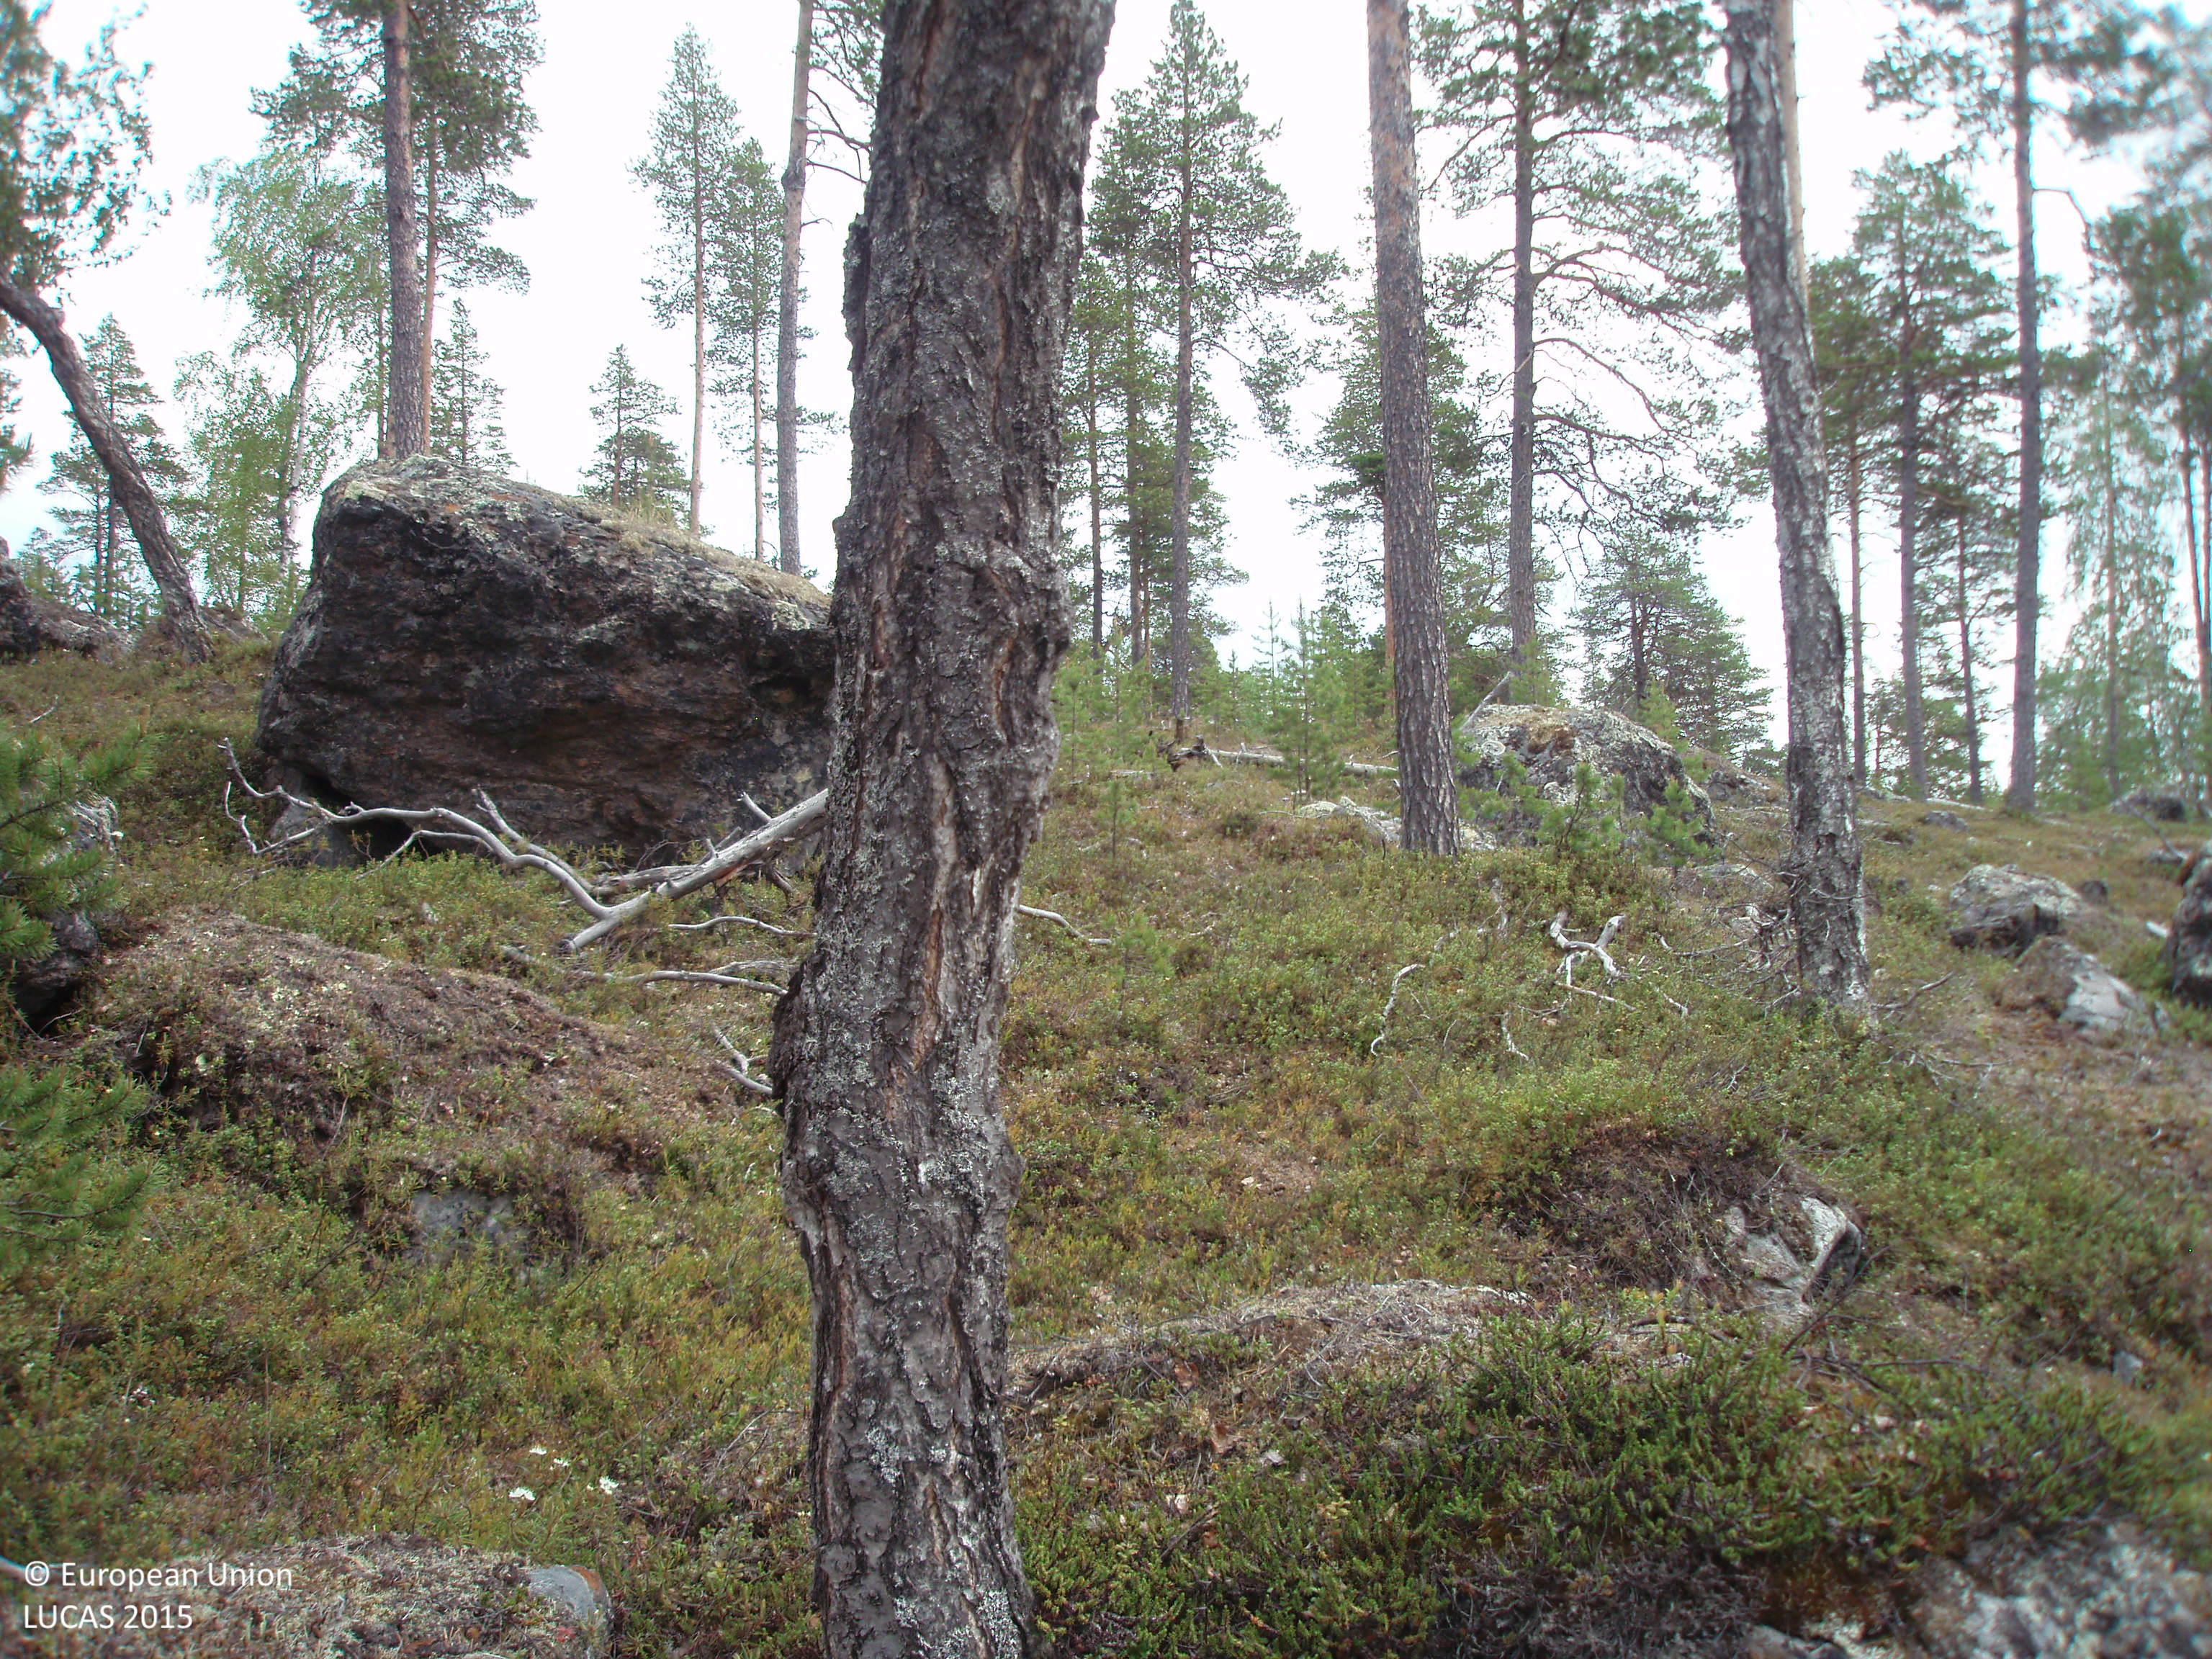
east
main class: Woodland
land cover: Pine dominated coniferous woodland
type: boreal forest
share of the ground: 25 - 50 %
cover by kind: shrubs 55 %, coniferous forest trees 30 %, broadleaved forest trees 5 %, lichens and mosses 5 %, unconsolidated bare surface 5 %
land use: Forestry
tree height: > 5 m
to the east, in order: Pine dominated coniferous woodland; Pine dominated mixed woodland; Pine dominated coniferous woodland
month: June
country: FI
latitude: 68.8054
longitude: 28.1104
